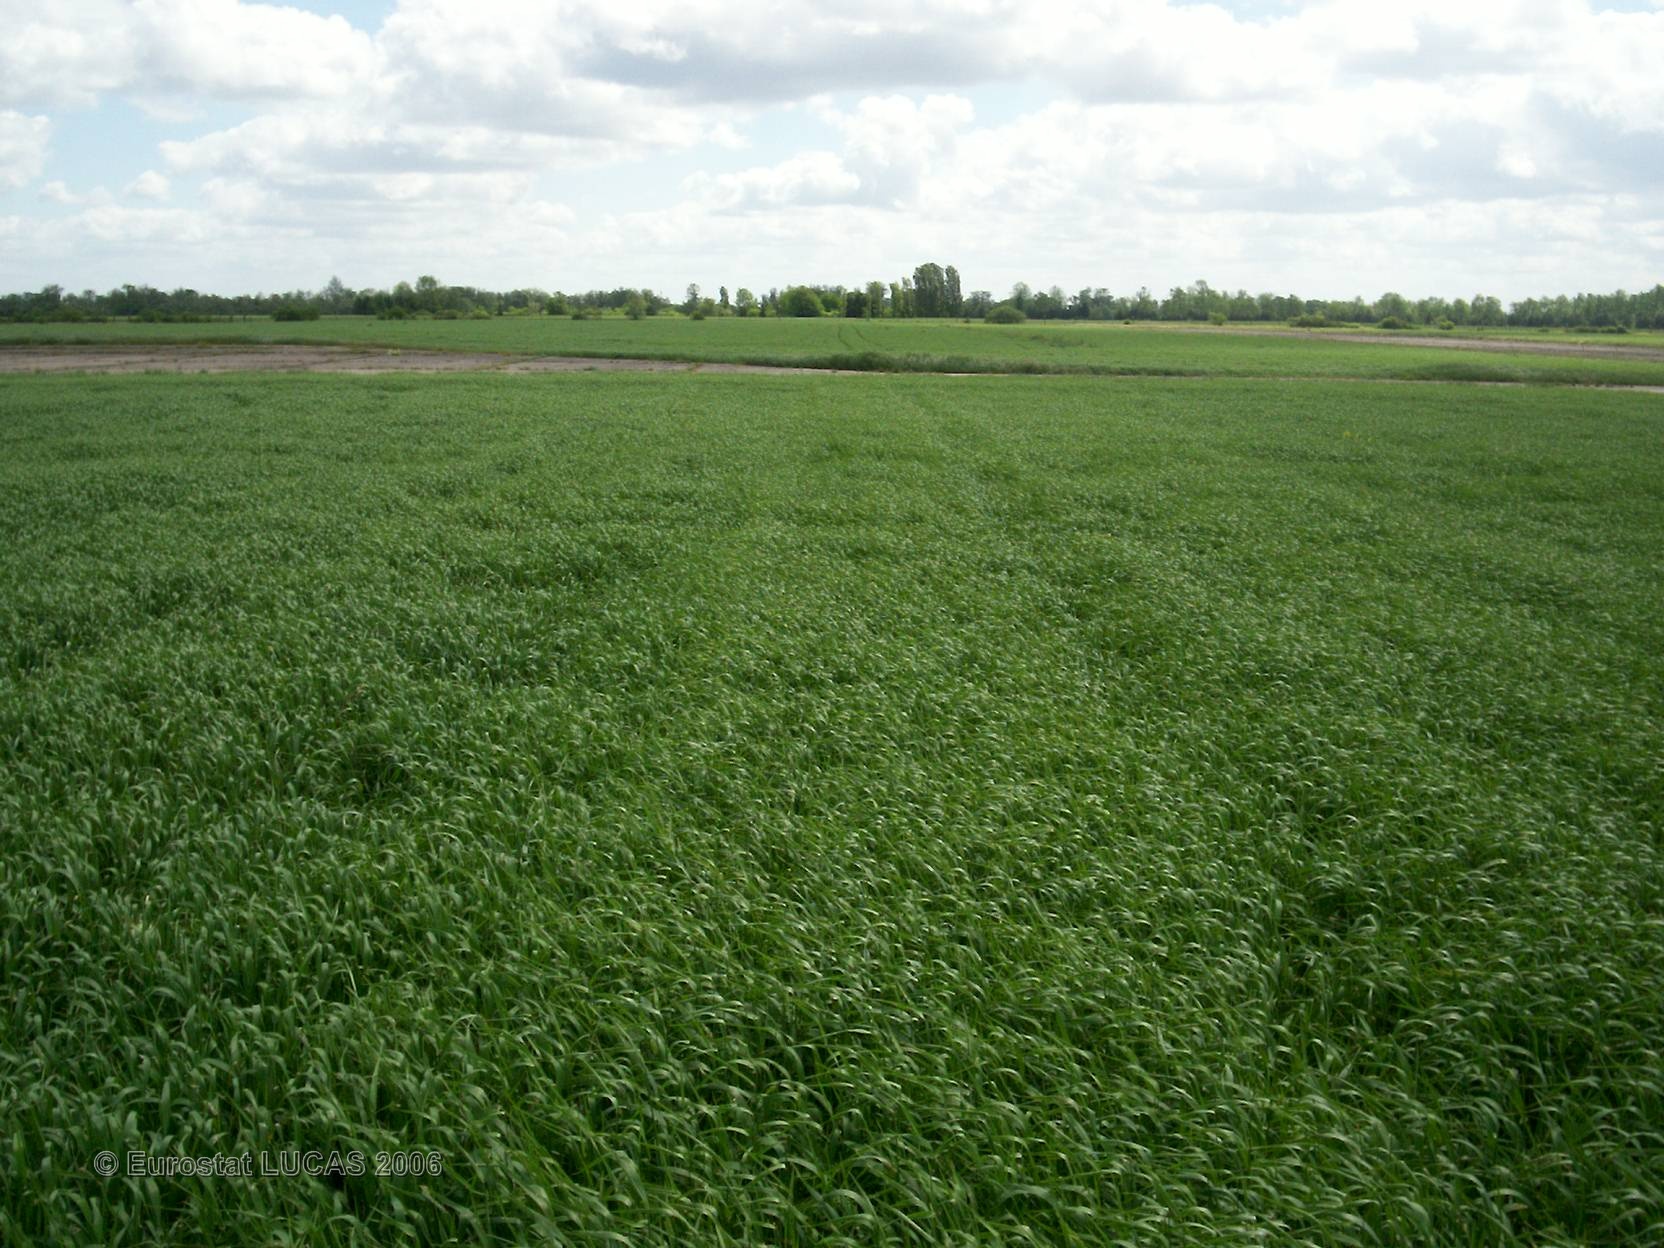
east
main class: Cropland
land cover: Barley
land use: Agriculture (excluding fallow land and kitchen gardens)
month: May
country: FR
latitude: 48.4288
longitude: 4.4968
